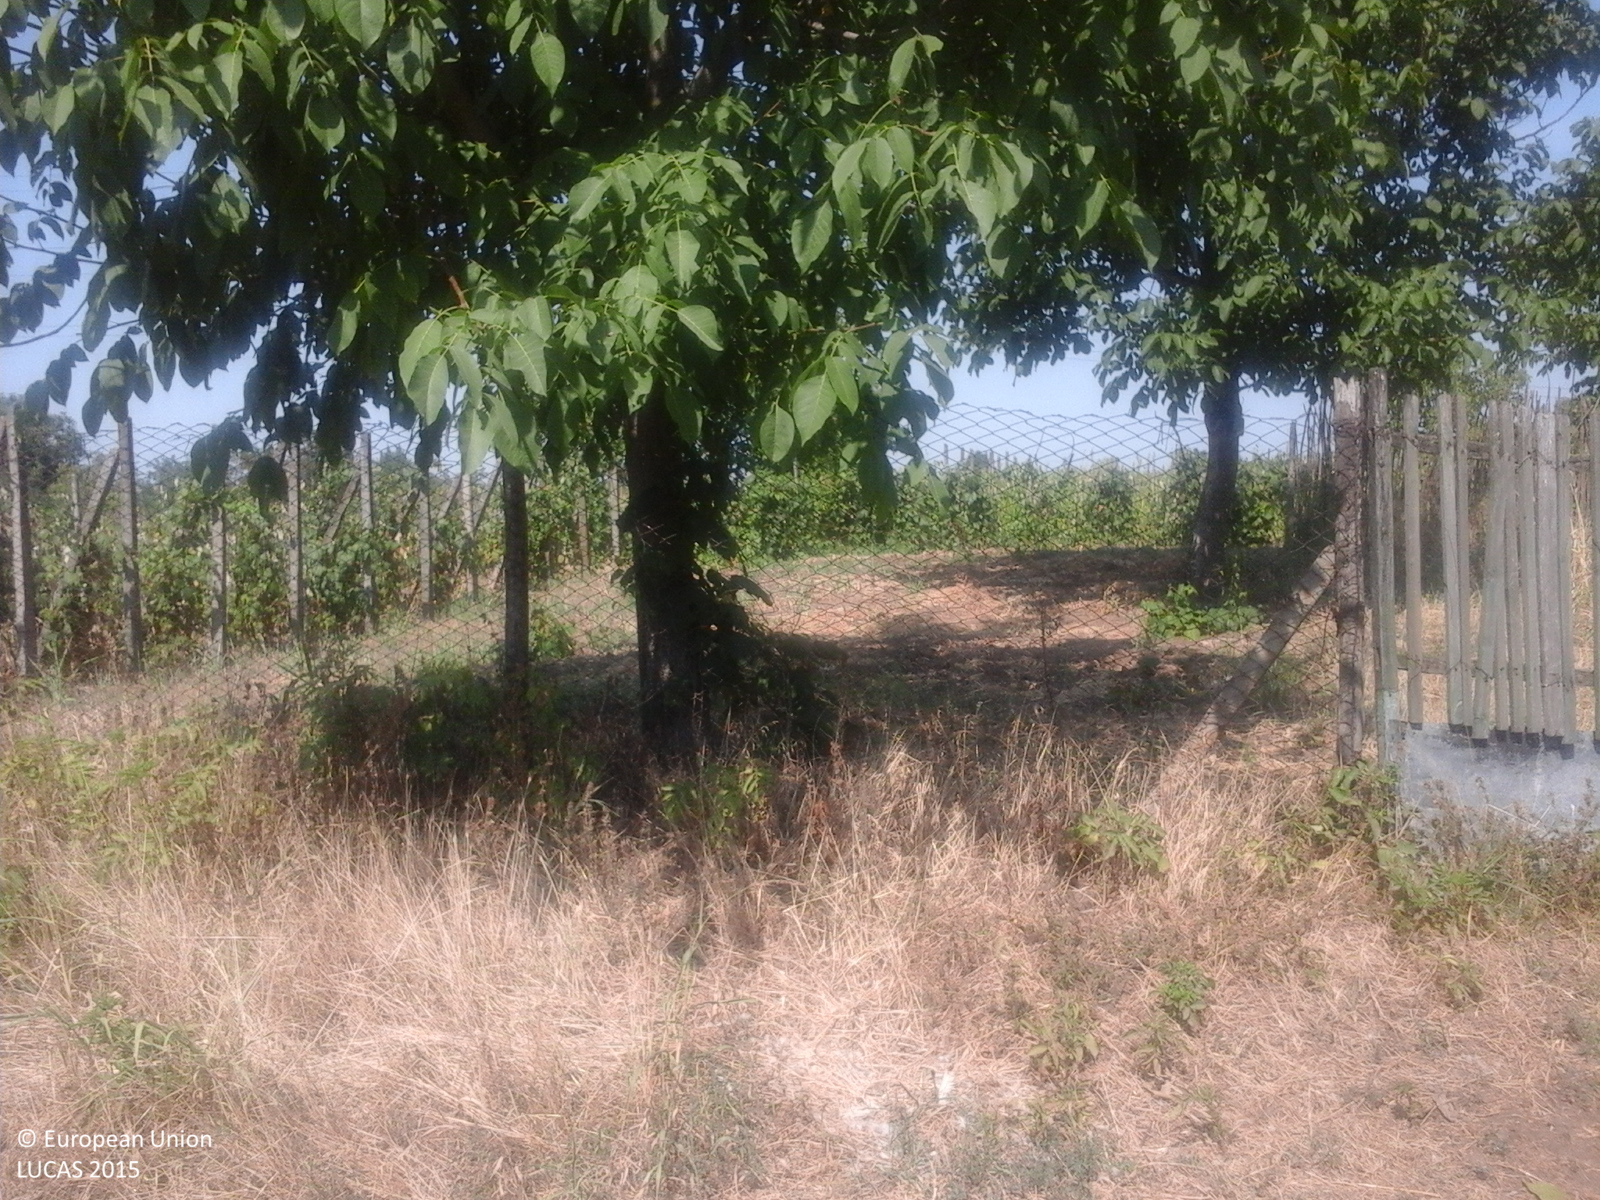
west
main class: Cropland
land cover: Vineyards
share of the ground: > 75 %
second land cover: Spontaneously vegetated surfaces
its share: 25 - 50 %
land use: Agriculture (excluding fallow land and kitchen gardens)
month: August
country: RO
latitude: 44.2141
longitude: 22.9210
